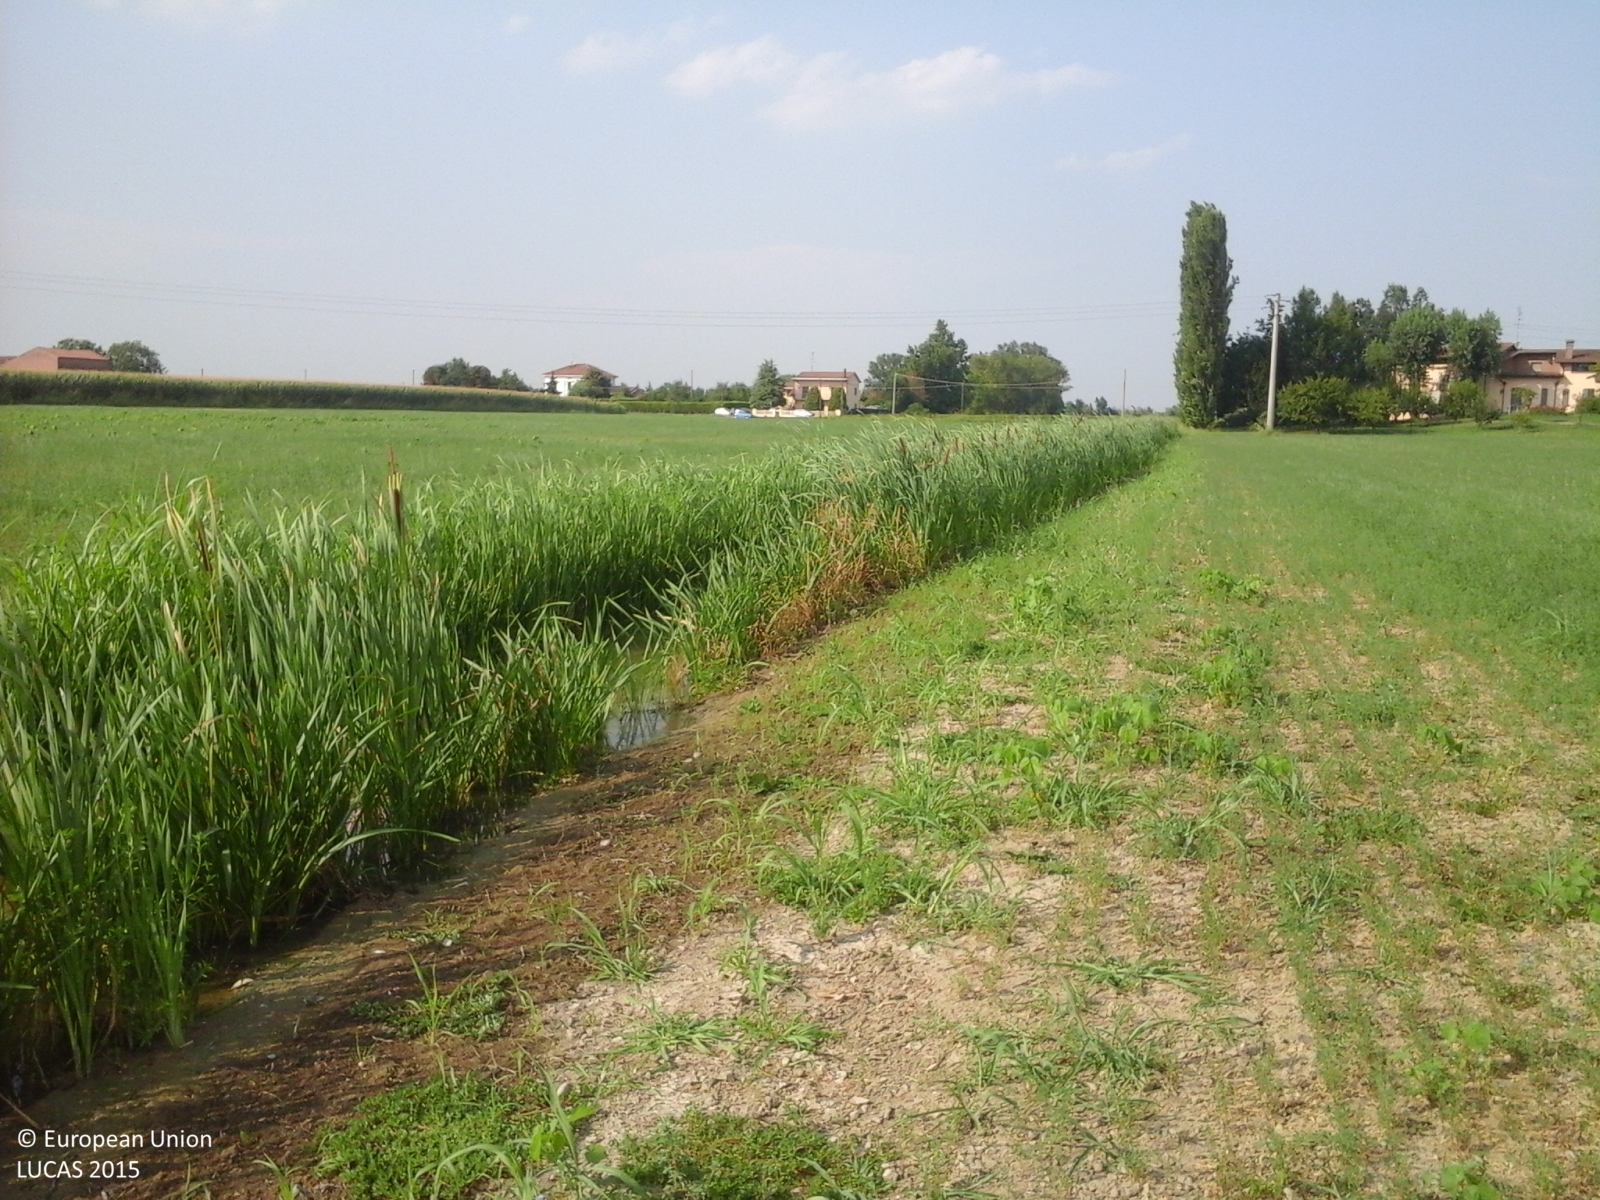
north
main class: Cropland
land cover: Lucerne
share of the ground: 25 - 50 %
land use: Agriculture (excluding fallow land and kitchen gardens)
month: July
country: IT
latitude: 44.9426
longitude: 10.7968
